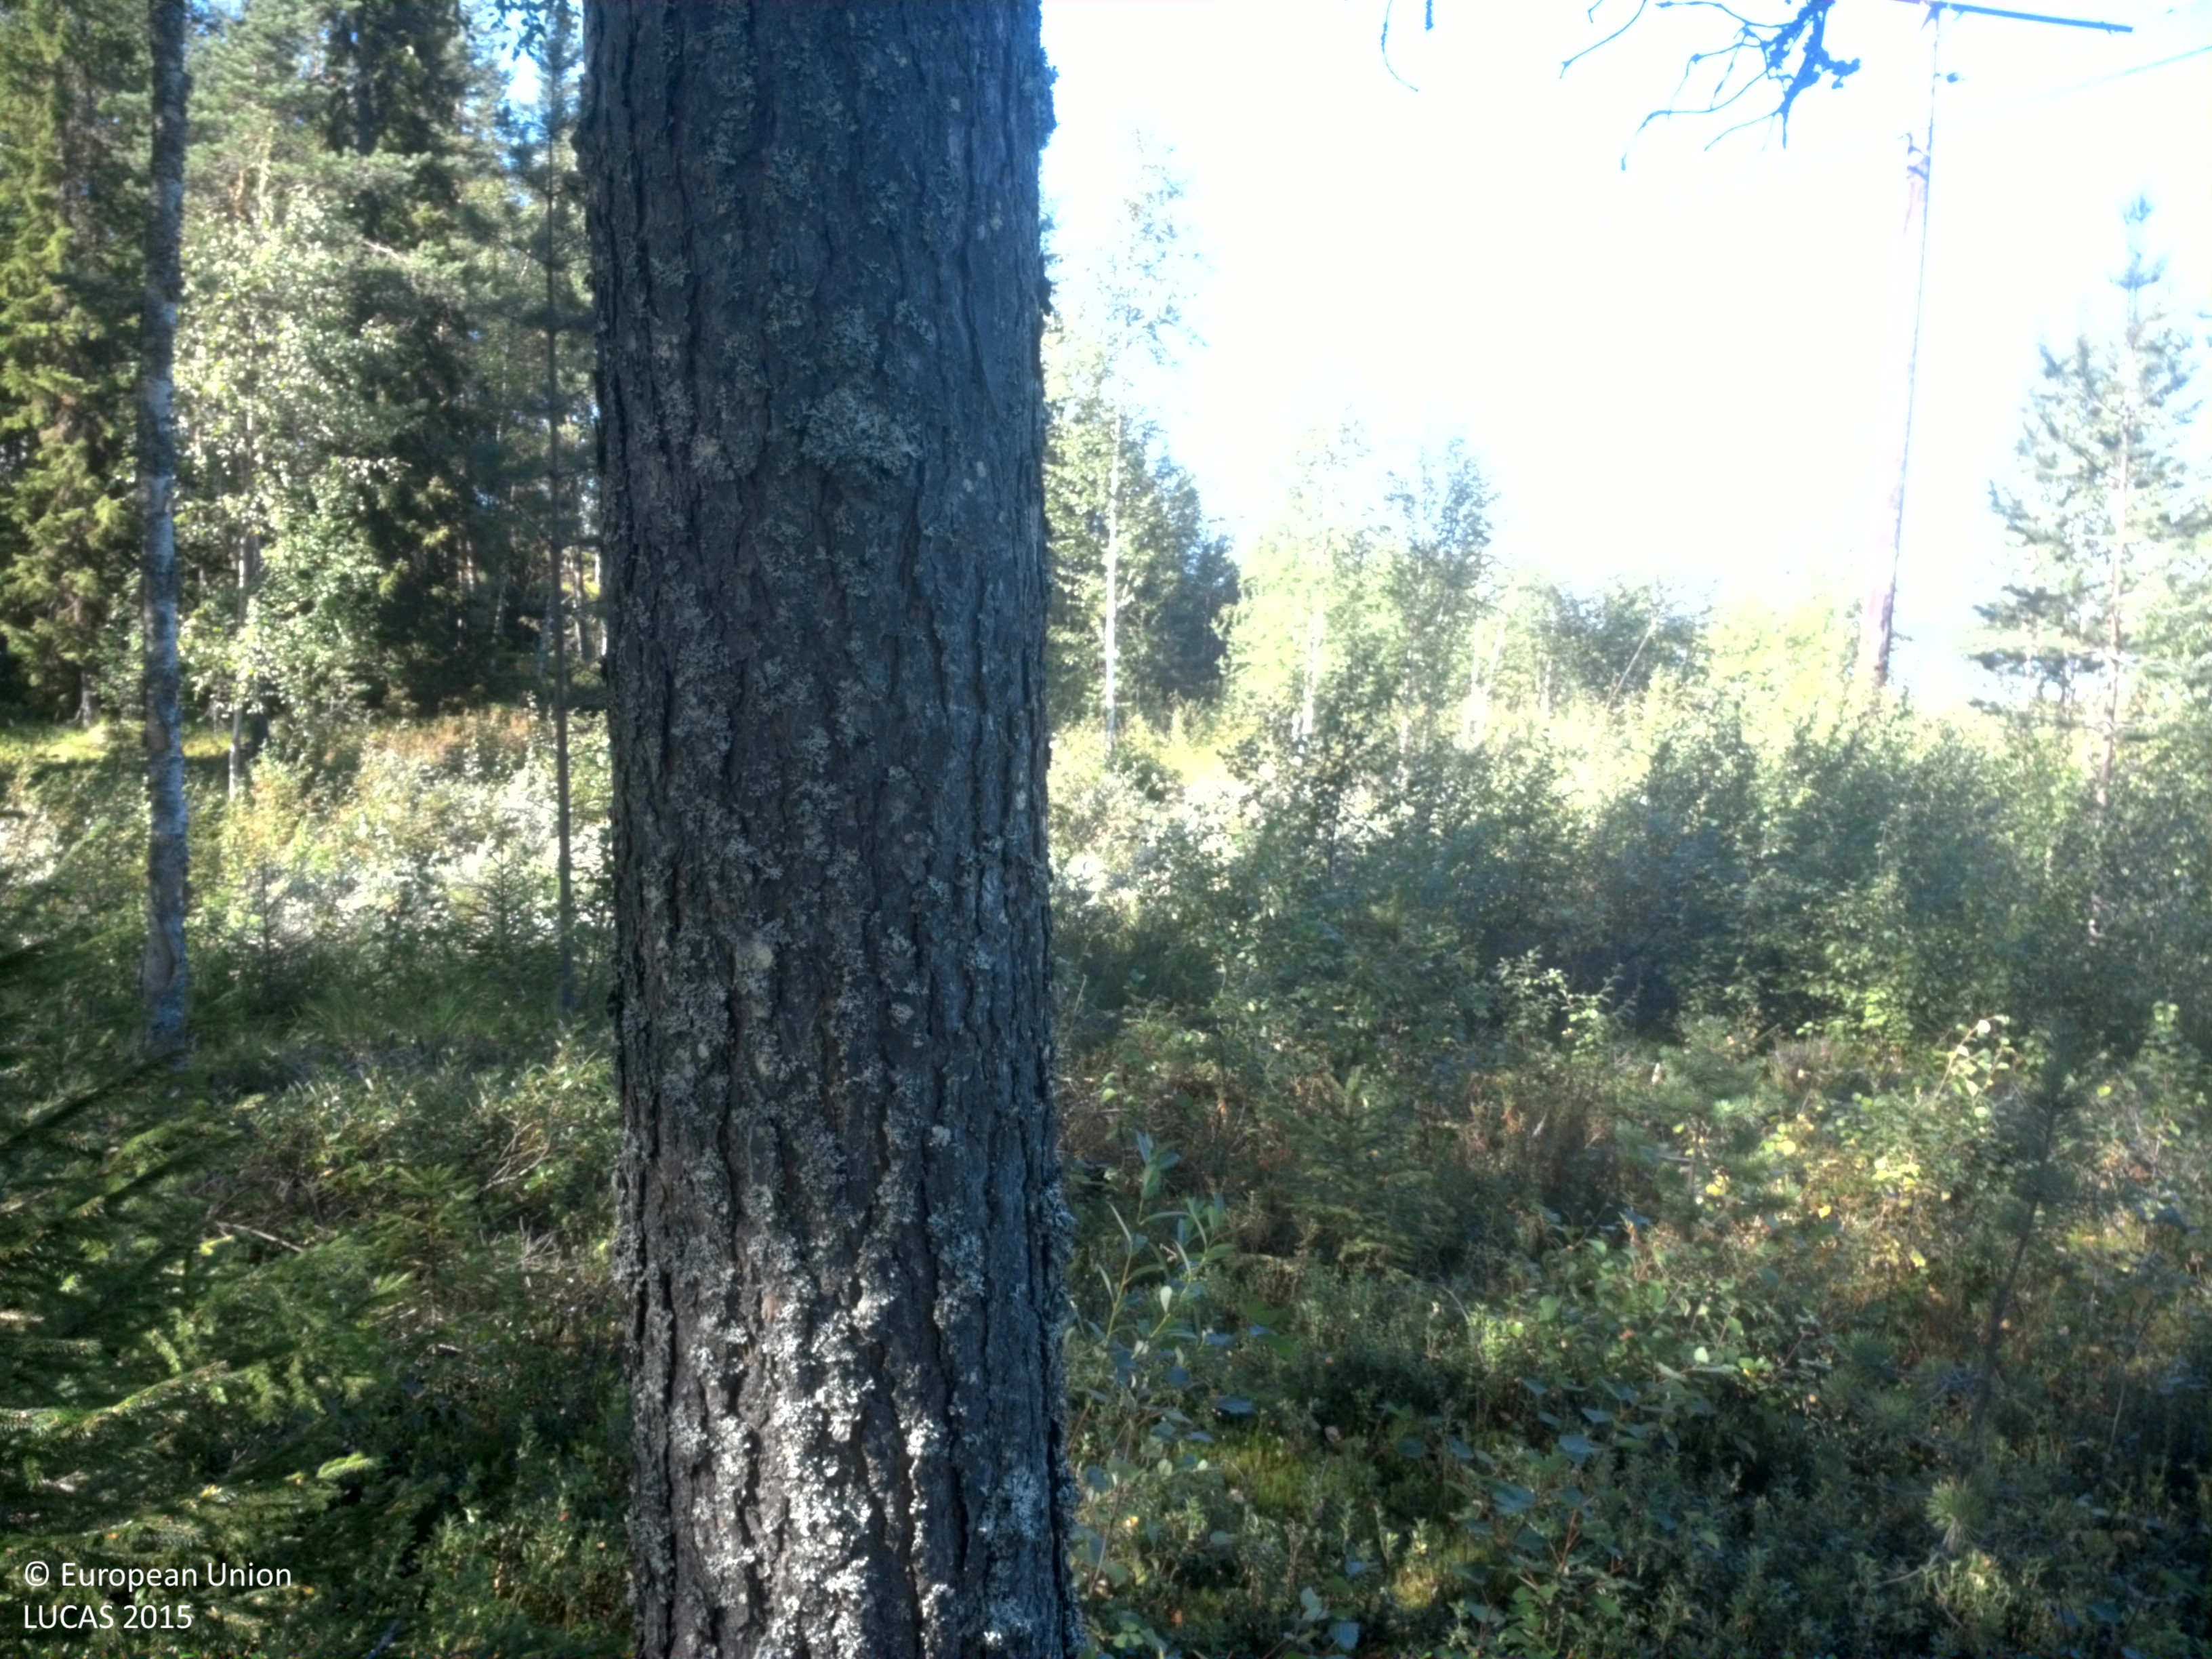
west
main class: Woodland
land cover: Pine dominated mixed woodland
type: boreal forest
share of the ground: 50 - 75 %
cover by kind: coniferous forest trees 45 %, shrubs 35 %, broadleaved forest trees 15 %, lichens and mosses 5 %
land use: Forestry
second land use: Amenities, museums, leisure
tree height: > 5 m
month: August
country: SE
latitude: 64.7106
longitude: 18.9262
